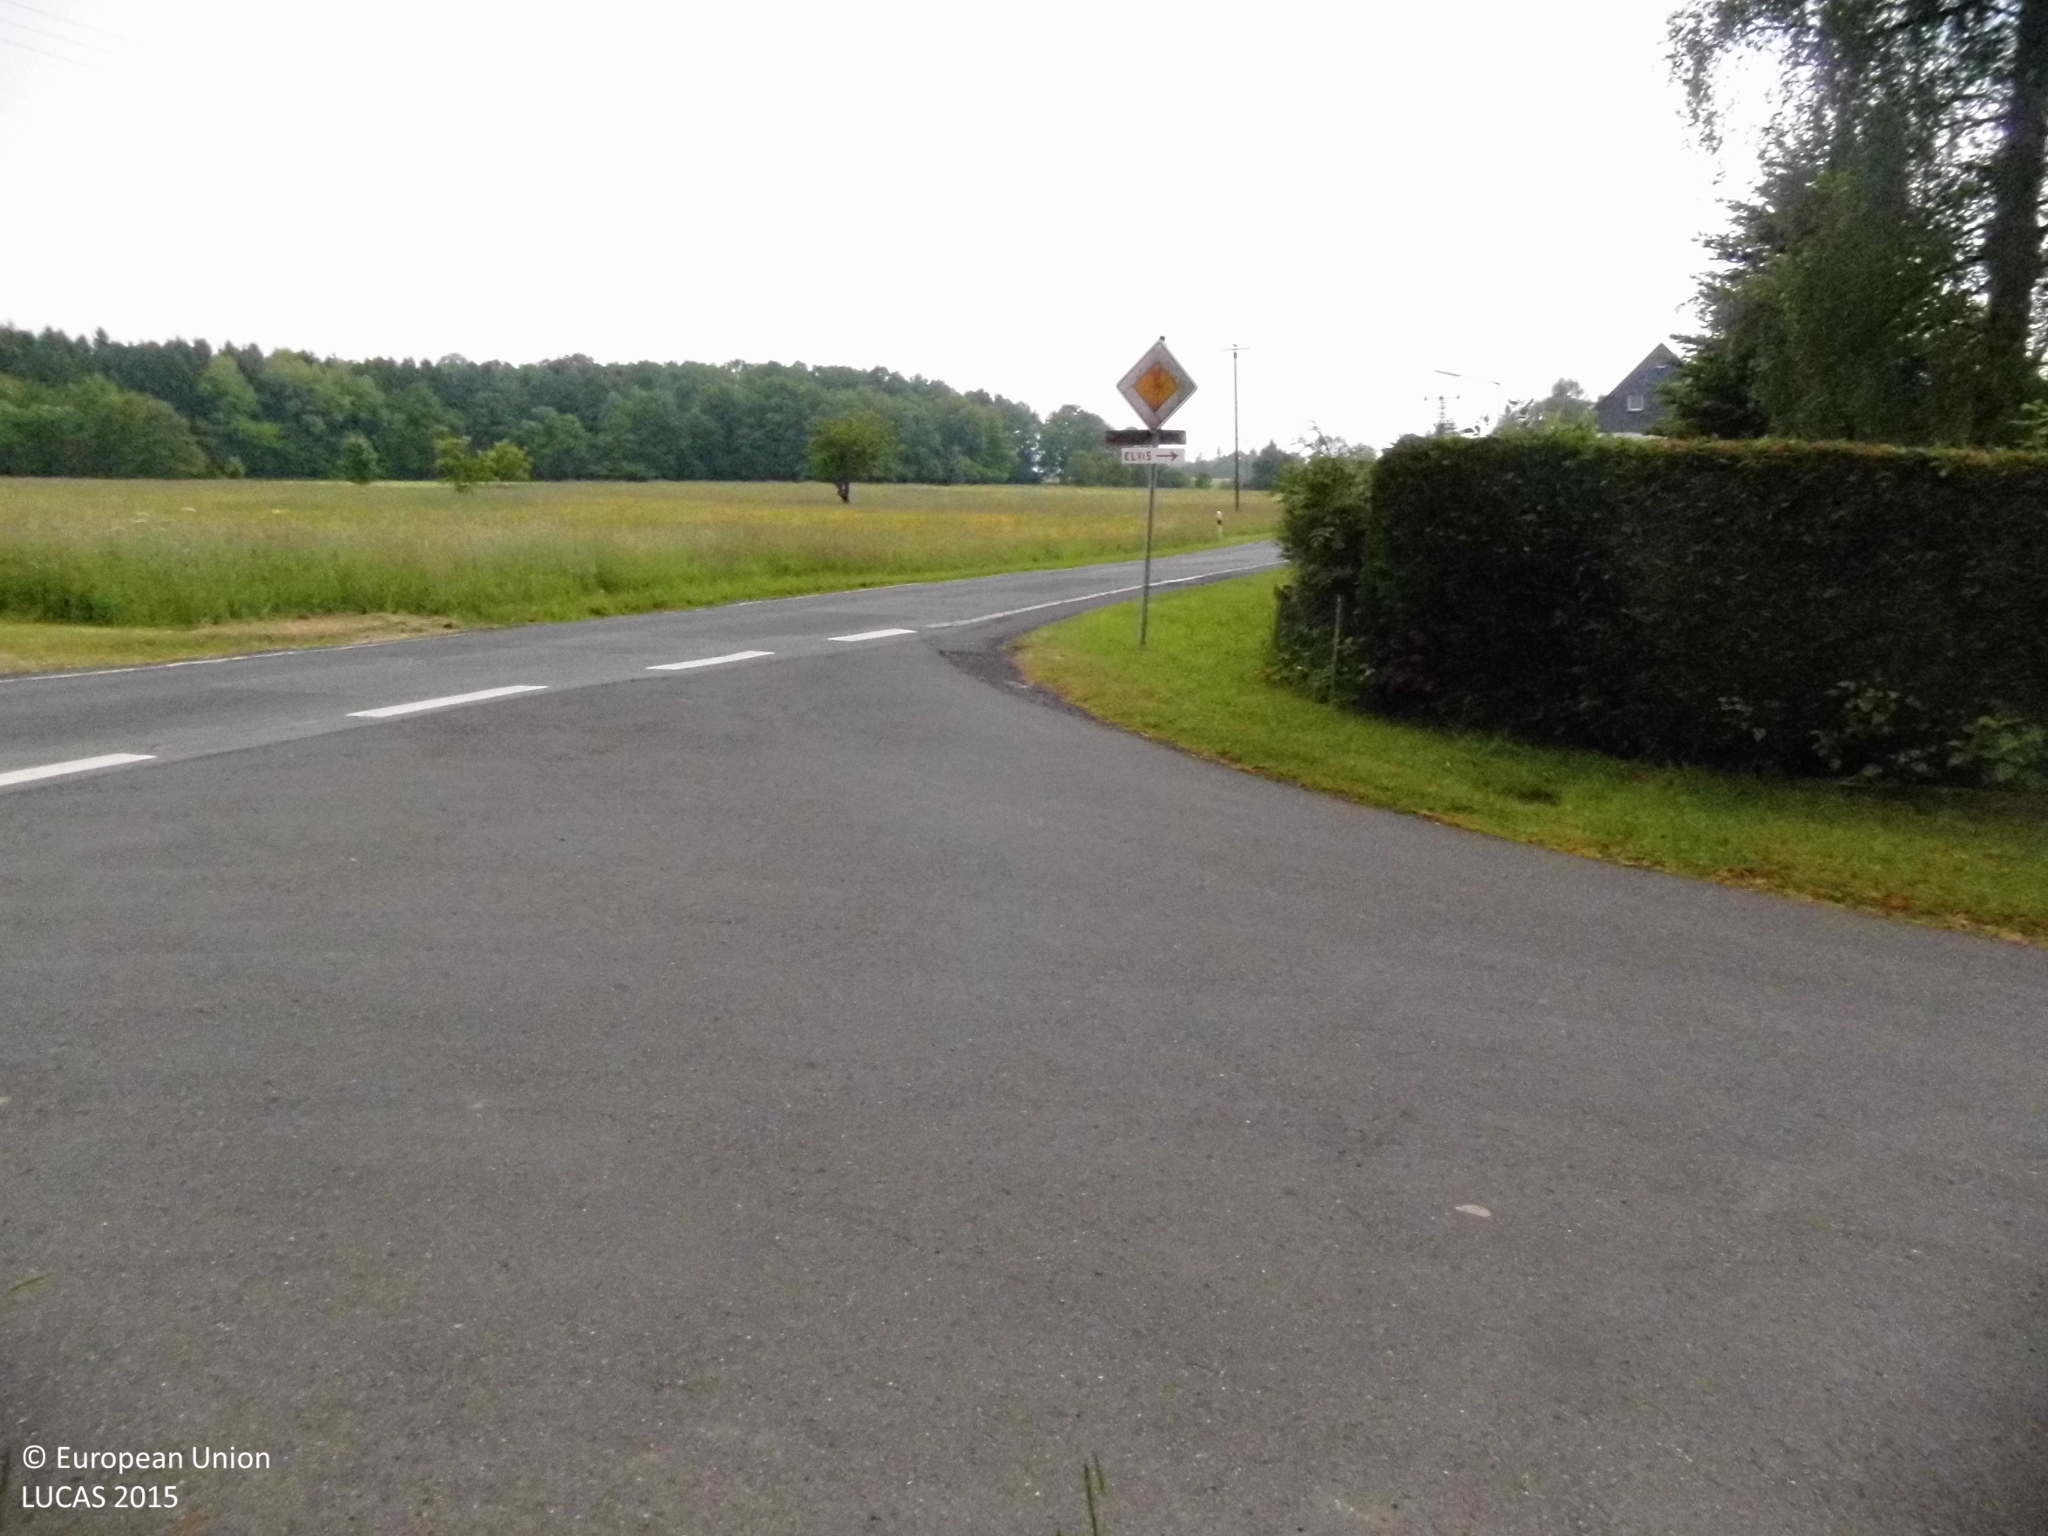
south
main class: Grassland
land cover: Grassland without tree/shrub cover
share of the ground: > 75 %
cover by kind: herbaceous plants 100 %
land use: Agriculture (excluding fallow land and kitchen gardens)
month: May
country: DE
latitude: 50.6958
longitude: 7.4661
